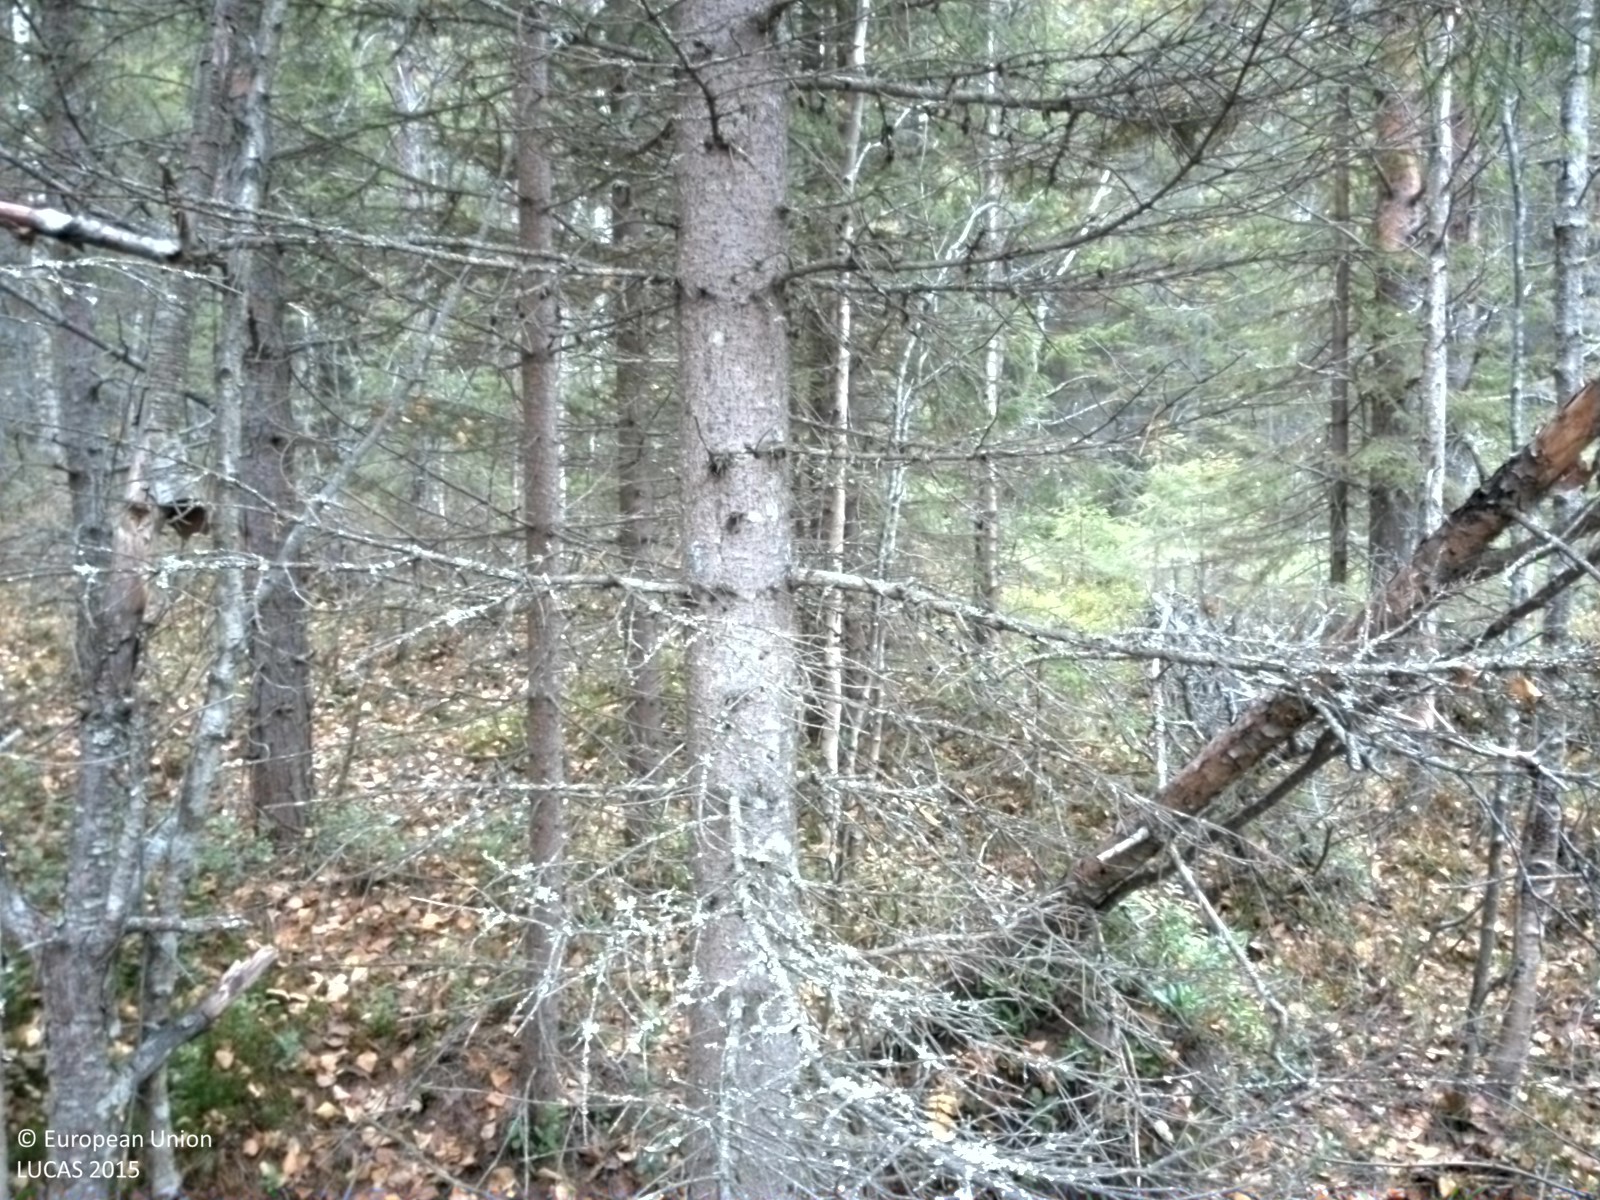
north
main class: Woodland
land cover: Other mixed woodland
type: boreal forest
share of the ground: 50 - 75 %
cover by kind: coniferous forest trees 35 %, broadleaved forest trees 30 %, shrubs 15 %, unconsolidated bare surface 15 %, lichens and mosses 5 %
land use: Forestry
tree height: > 5 m
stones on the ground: 25 - 50 %
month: October
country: SE
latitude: 65.4619
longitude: 20.9546
